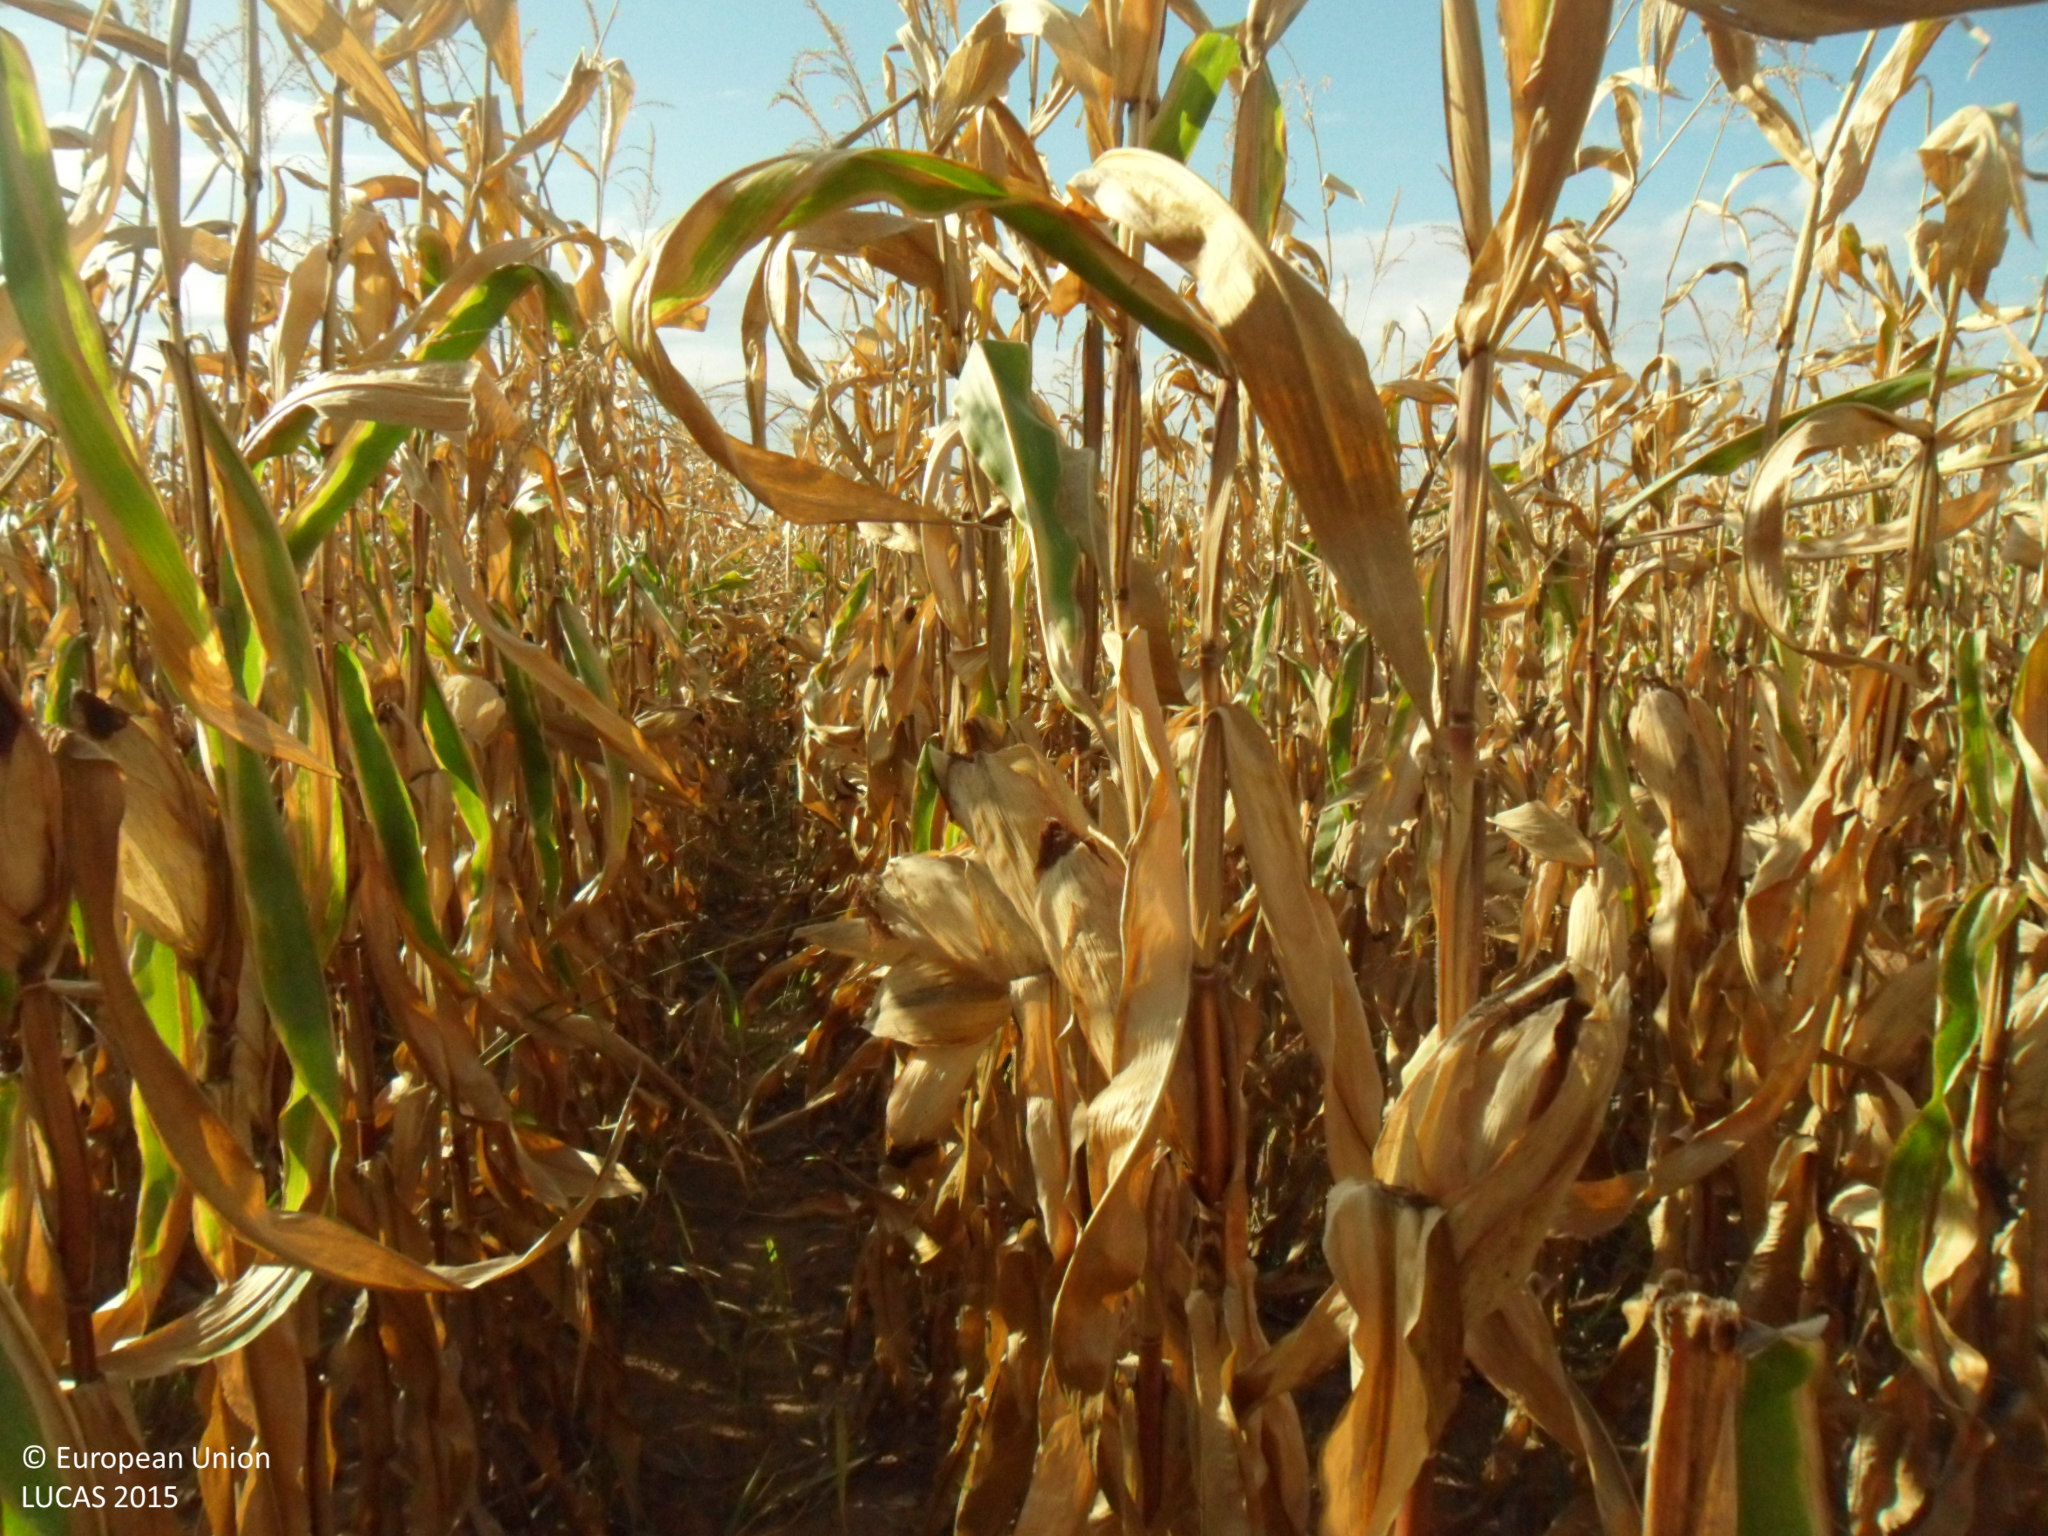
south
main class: Cropland
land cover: Maize
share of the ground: > 75 %
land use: Agriculture (excluding fallow land and kitchen gardens)
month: September
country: BG
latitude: 43.5958
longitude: 26.3413
